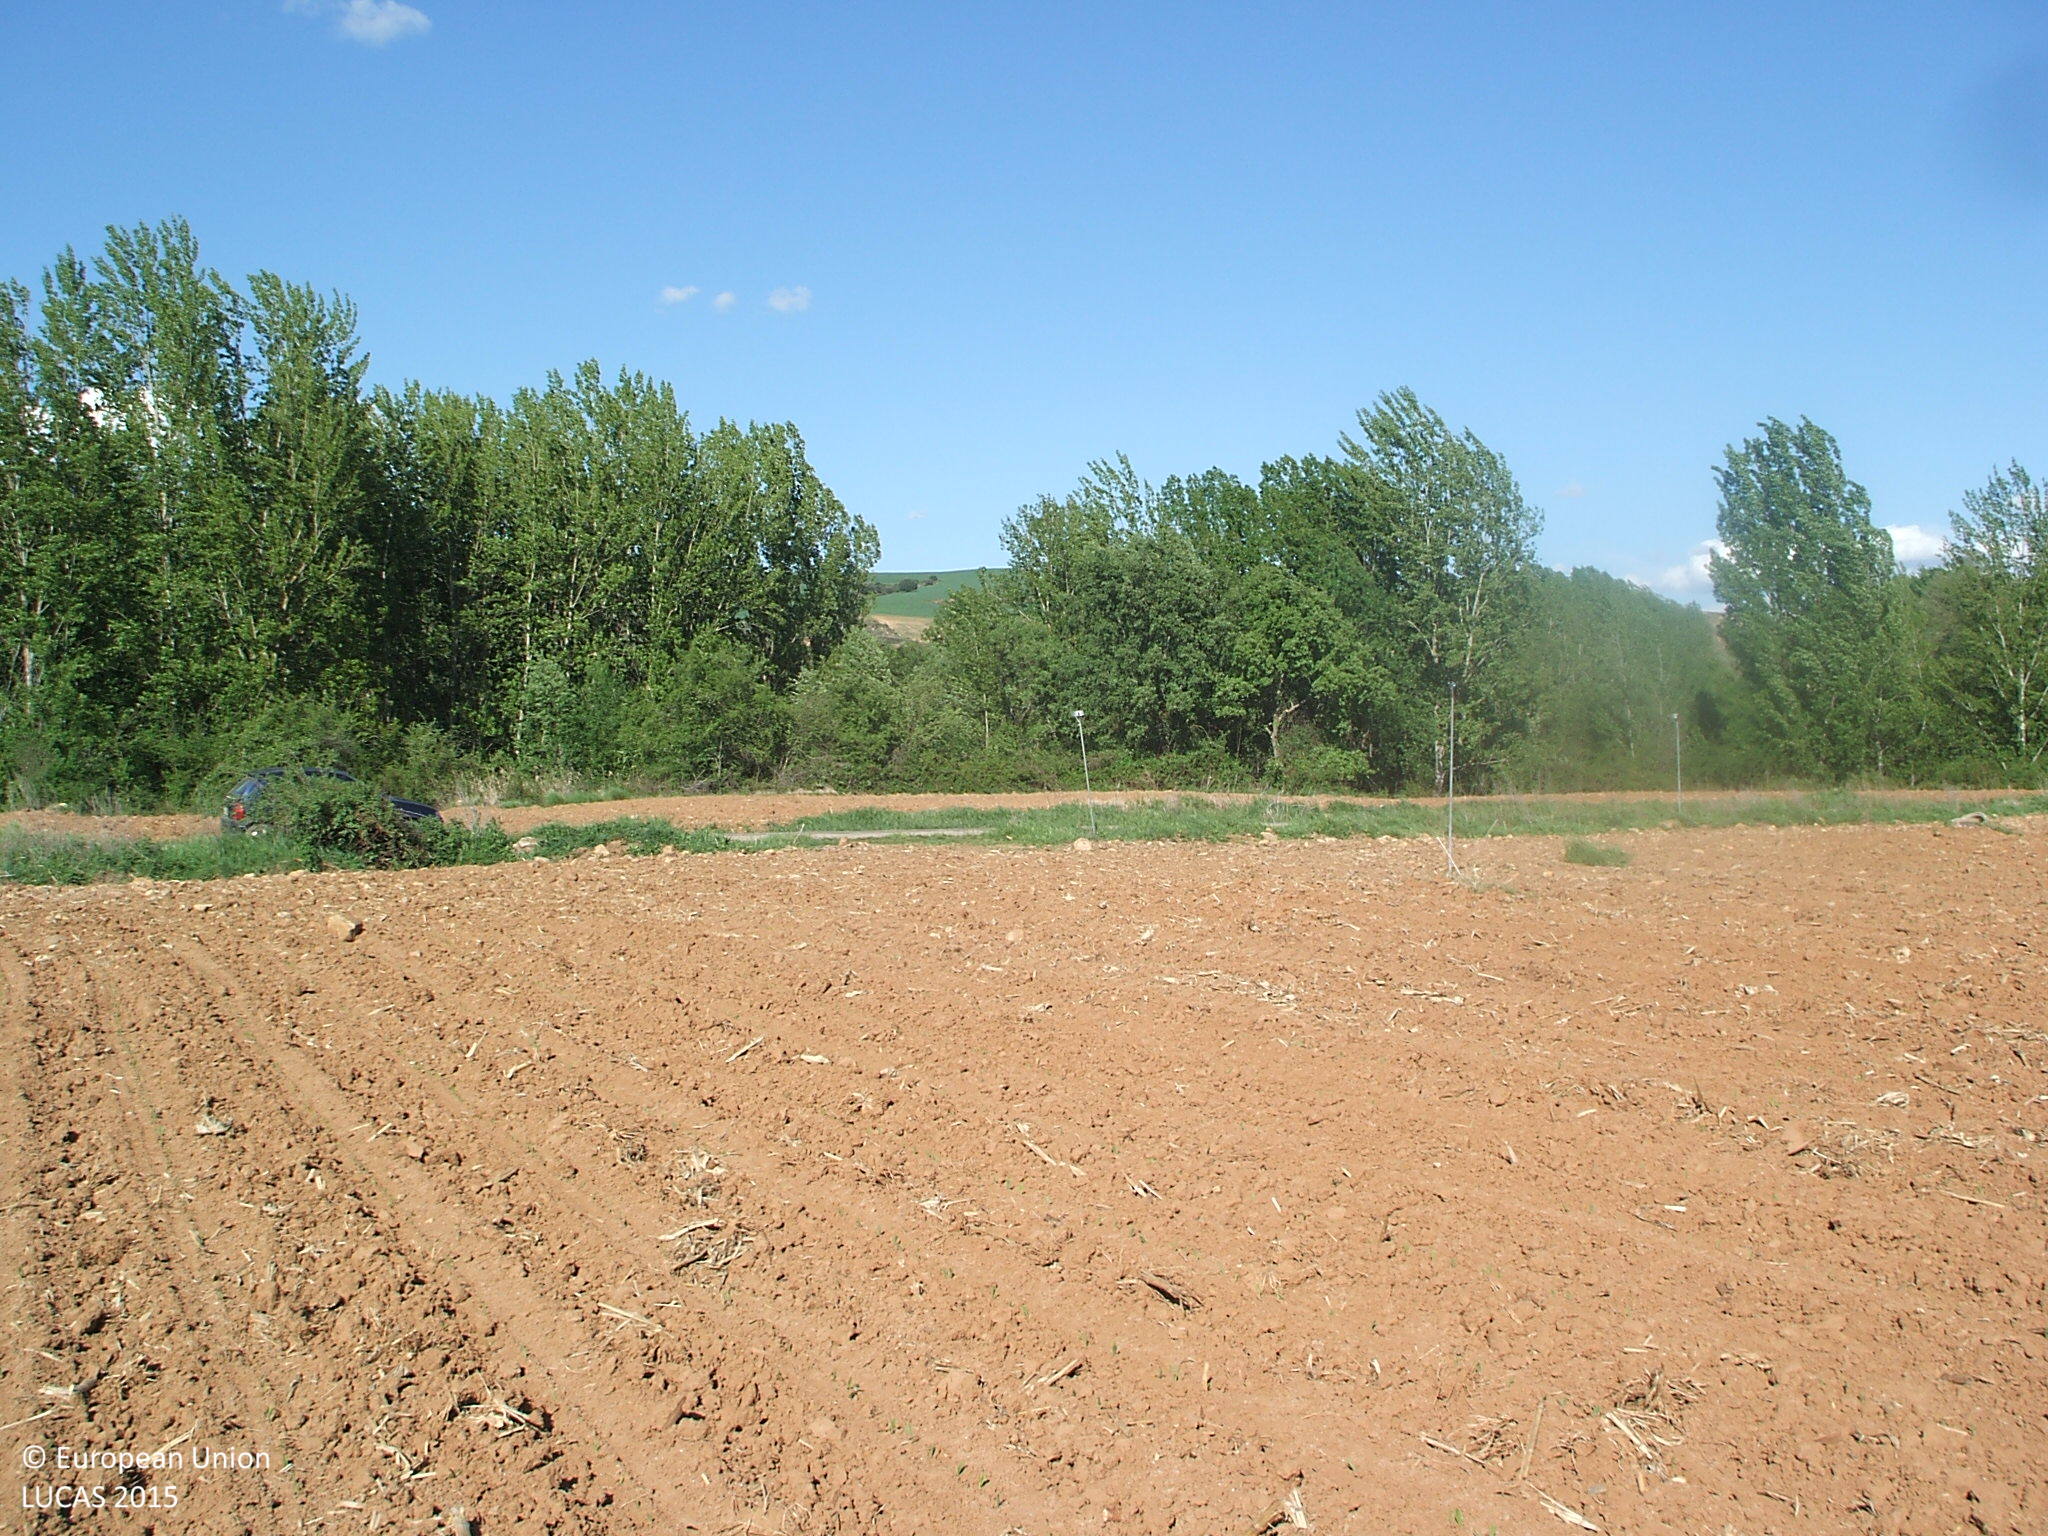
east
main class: Cropland
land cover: Maize
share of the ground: < 10 %
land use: Agriculture (excluding fallow land and kitchen gardens)
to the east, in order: Maize; Paved roads, cycling and walking lanes; Other bare soil; Broadleaved woodland; Inland fresh running water; Broadleaved woodland; Grassland with sparse tree/shrub cover; Broadleaved woodland
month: May
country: ES
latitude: 40.9893
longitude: -3.0039
